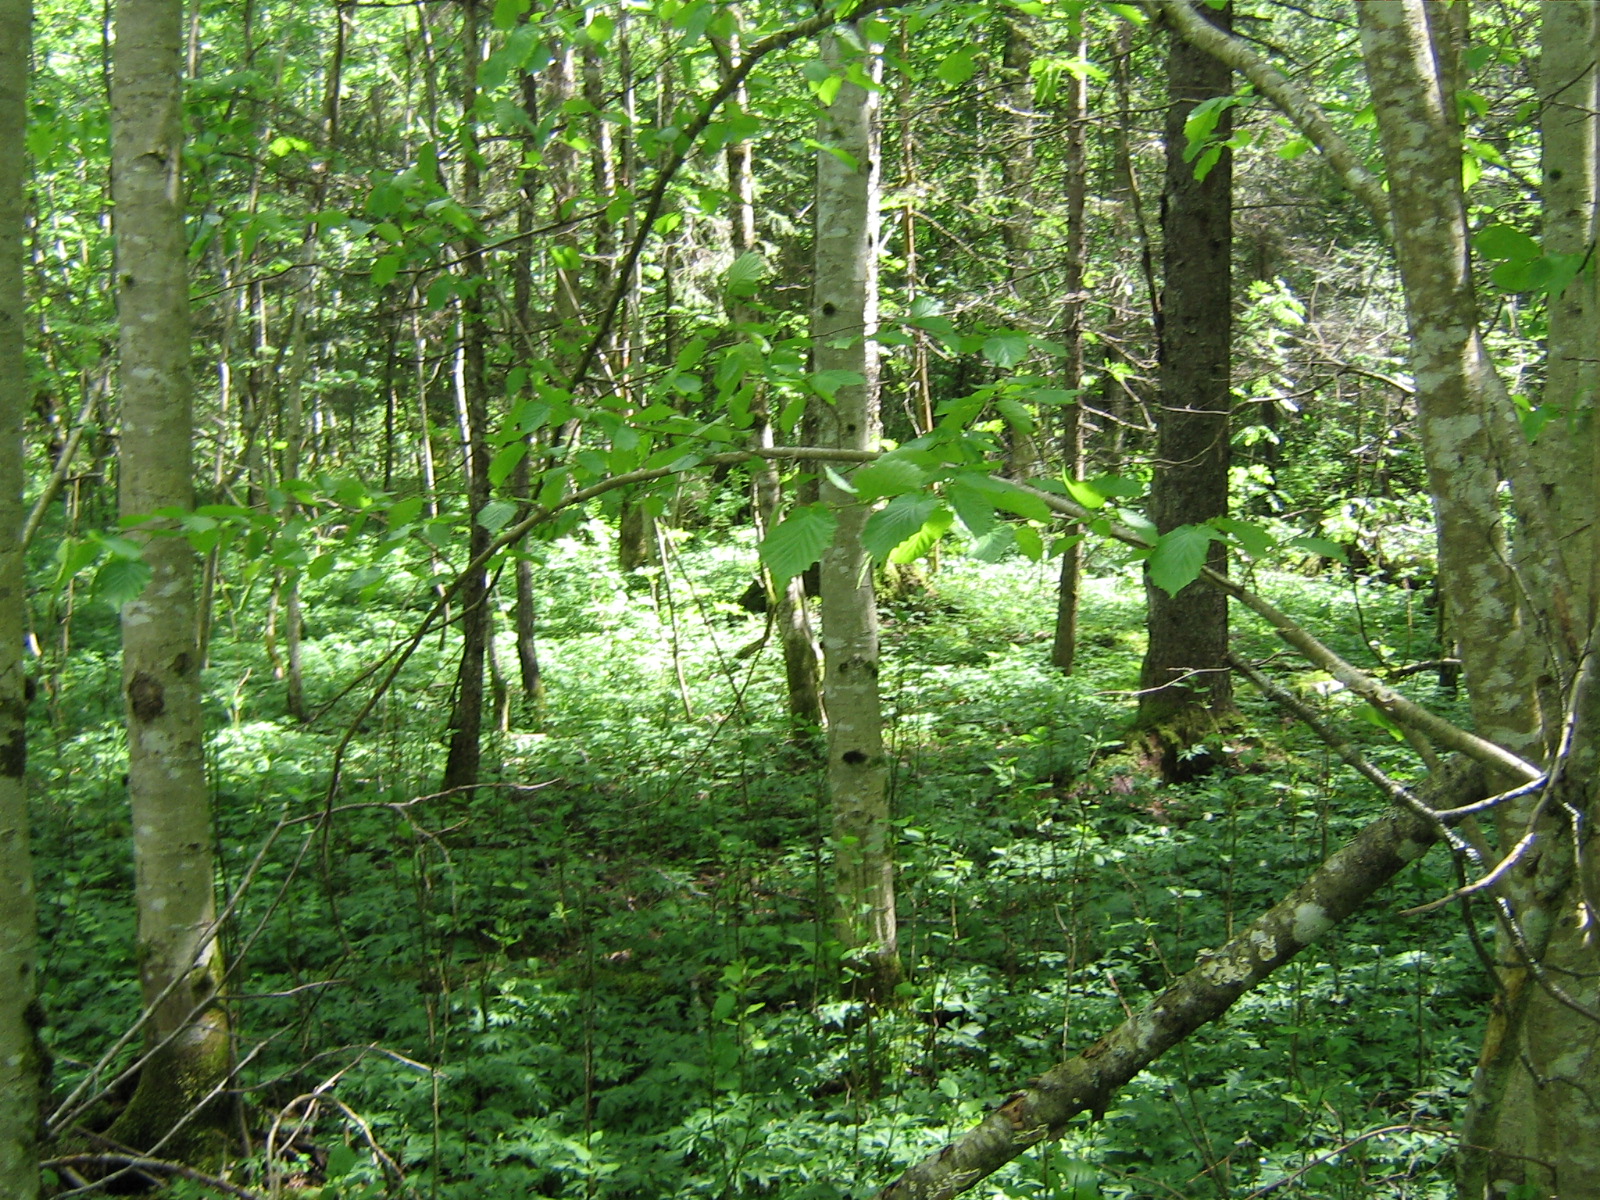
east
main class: Woodland
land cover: Broadleaved woodland
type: non-riverine alder, birch or aspen forest
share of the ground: > 75 %
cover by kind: broadleaved forest trees 100 %
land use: Forestry
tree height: > 5 m
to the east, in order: Broadleaved woodland; Other mixed woodland; Grassland with sparse tree/shrub cover; Broadleaved woodland; Grassland without tree/shrub cover
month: May
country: LV
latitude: 57.0237
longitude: 25.4529
